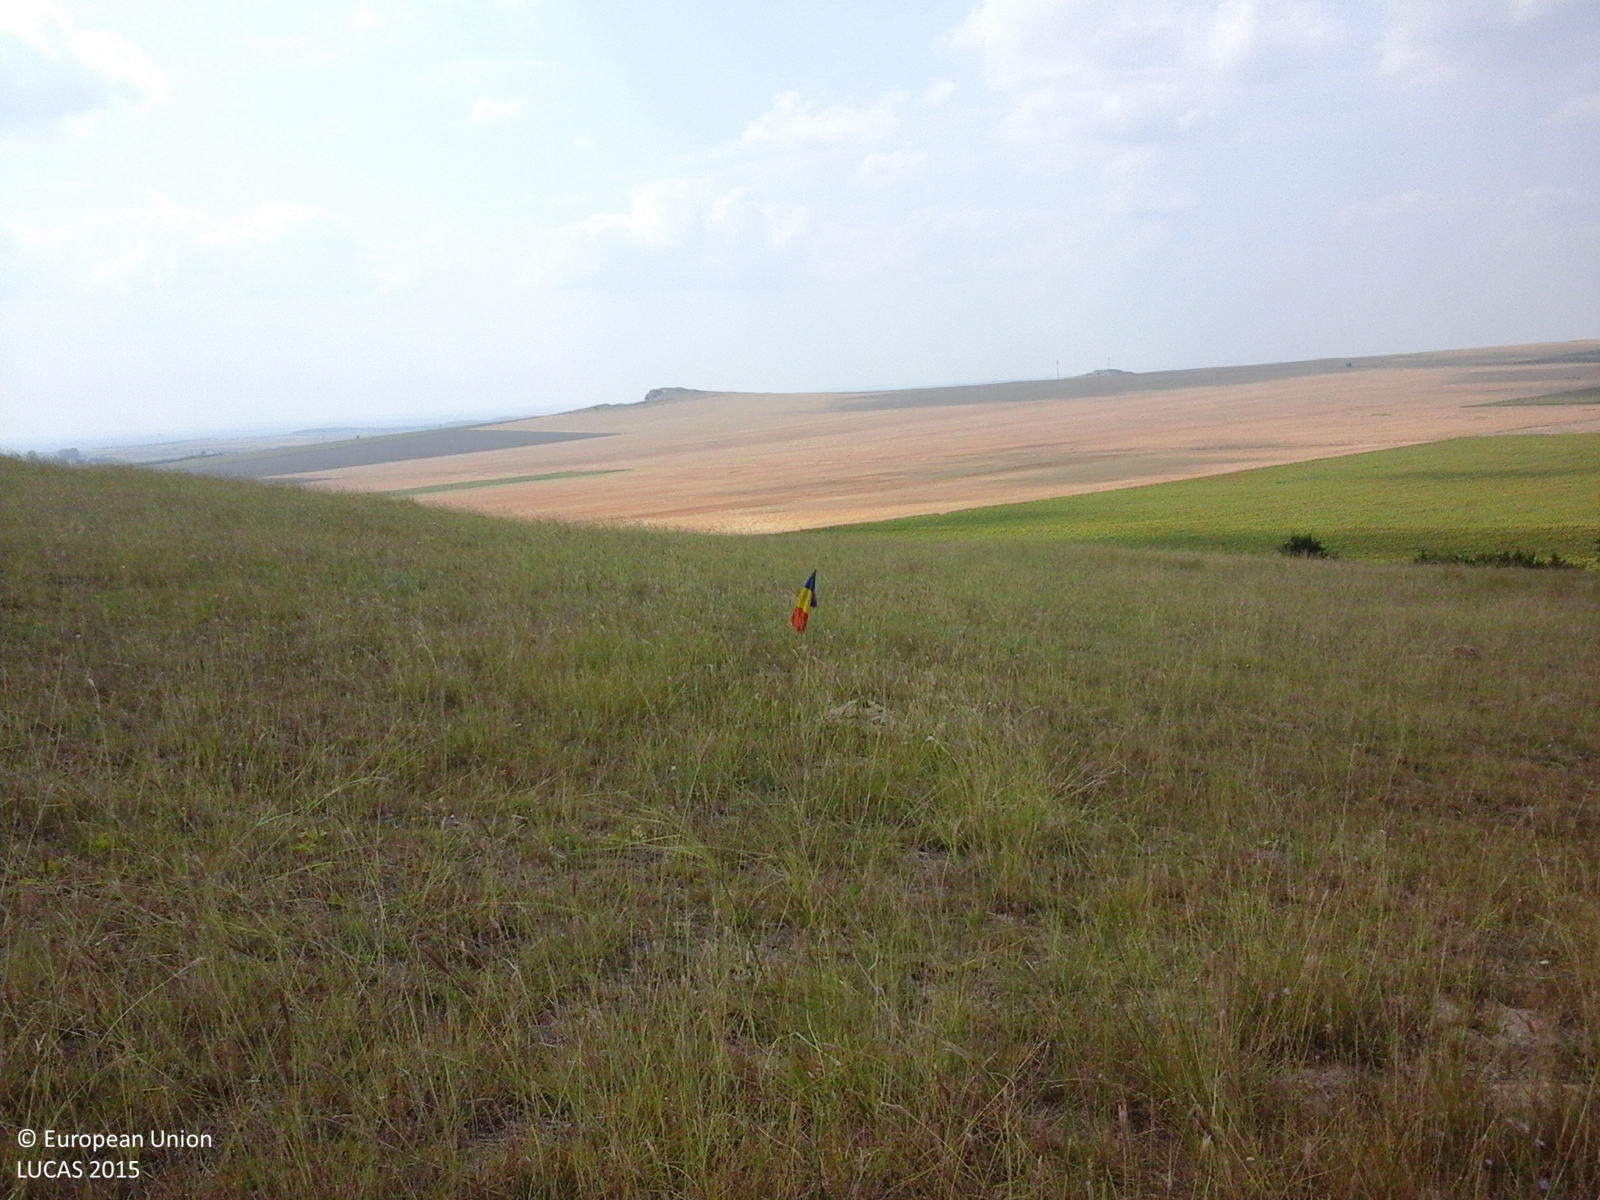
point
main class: Grassland
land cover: Grassland without tree/shrub cover
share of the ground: > 75 %
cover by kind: herbaceous plants 100 %
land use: Agriculture (excluding fallow land and kitchen gardens)
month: July
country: RO
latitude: 45.1516
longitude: 28.2474
